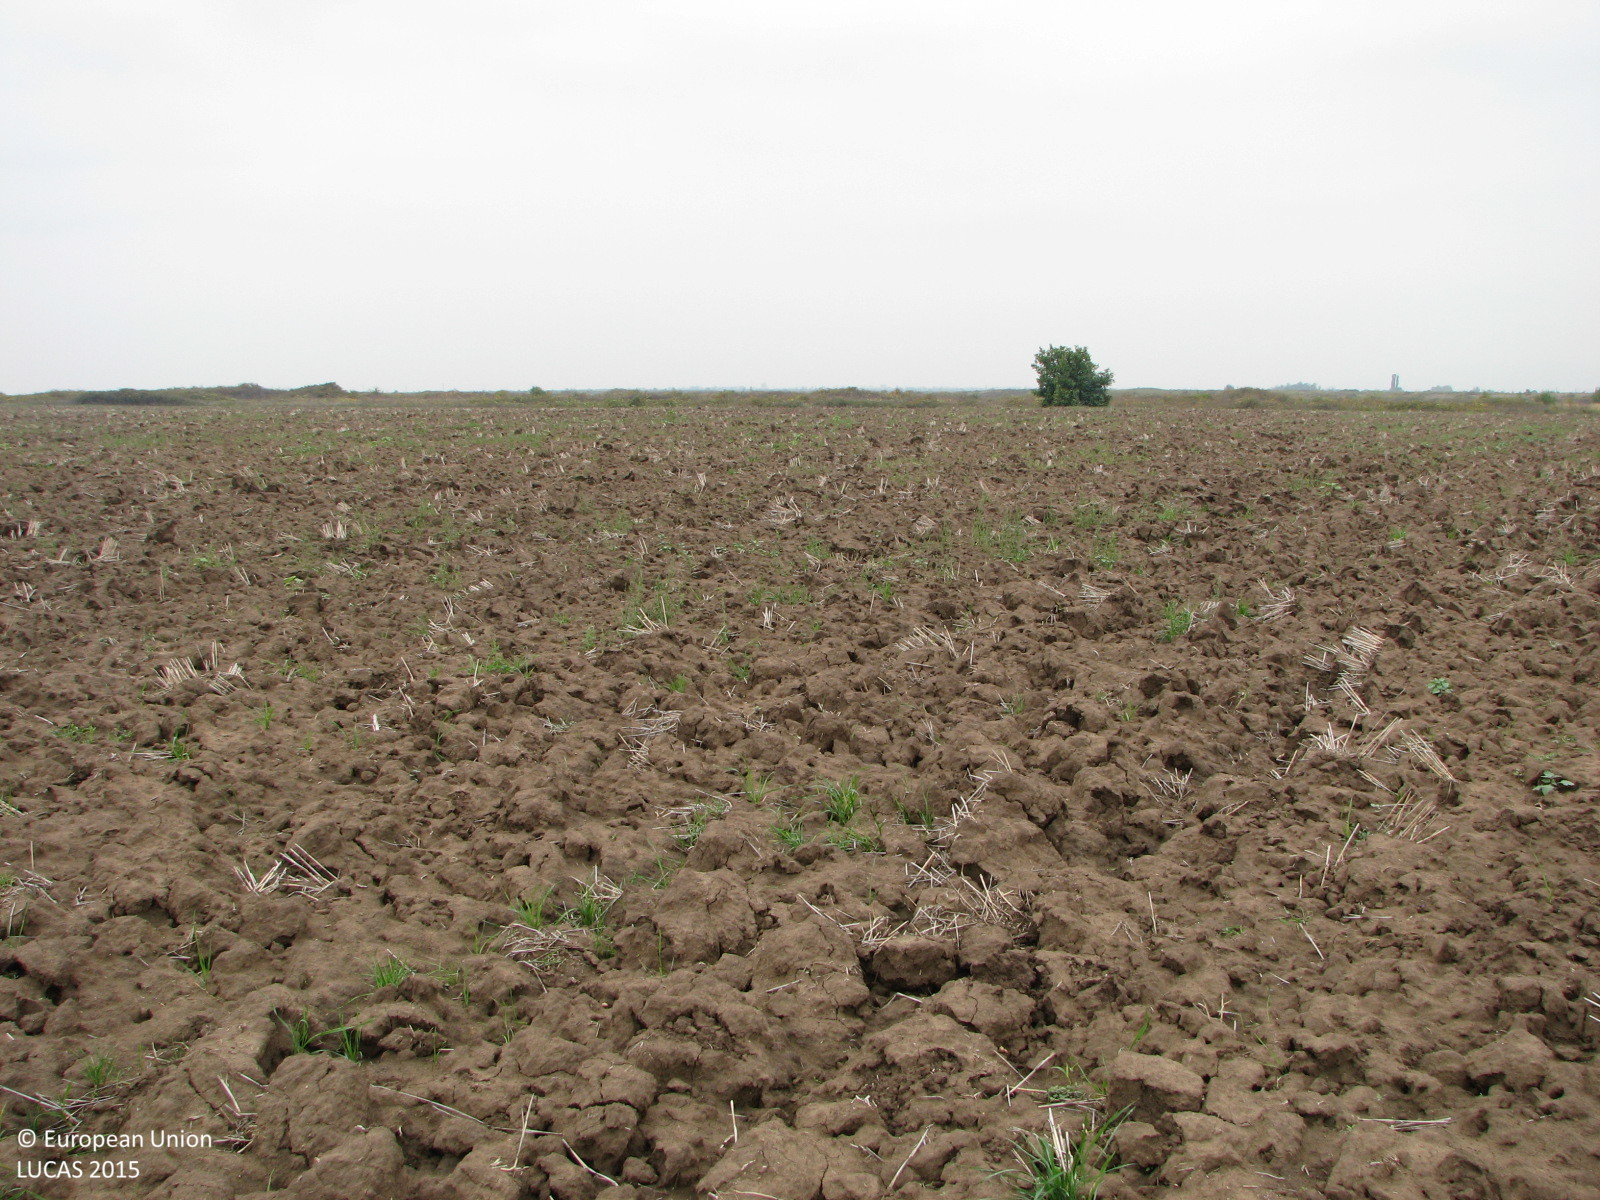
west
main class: Cropland
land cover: Common wheat
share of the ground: < 10 %
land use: Agriculture (excluding fallow land and kitchen gardens)
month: October
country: BG
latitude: 42.5896
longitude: 26.7579
